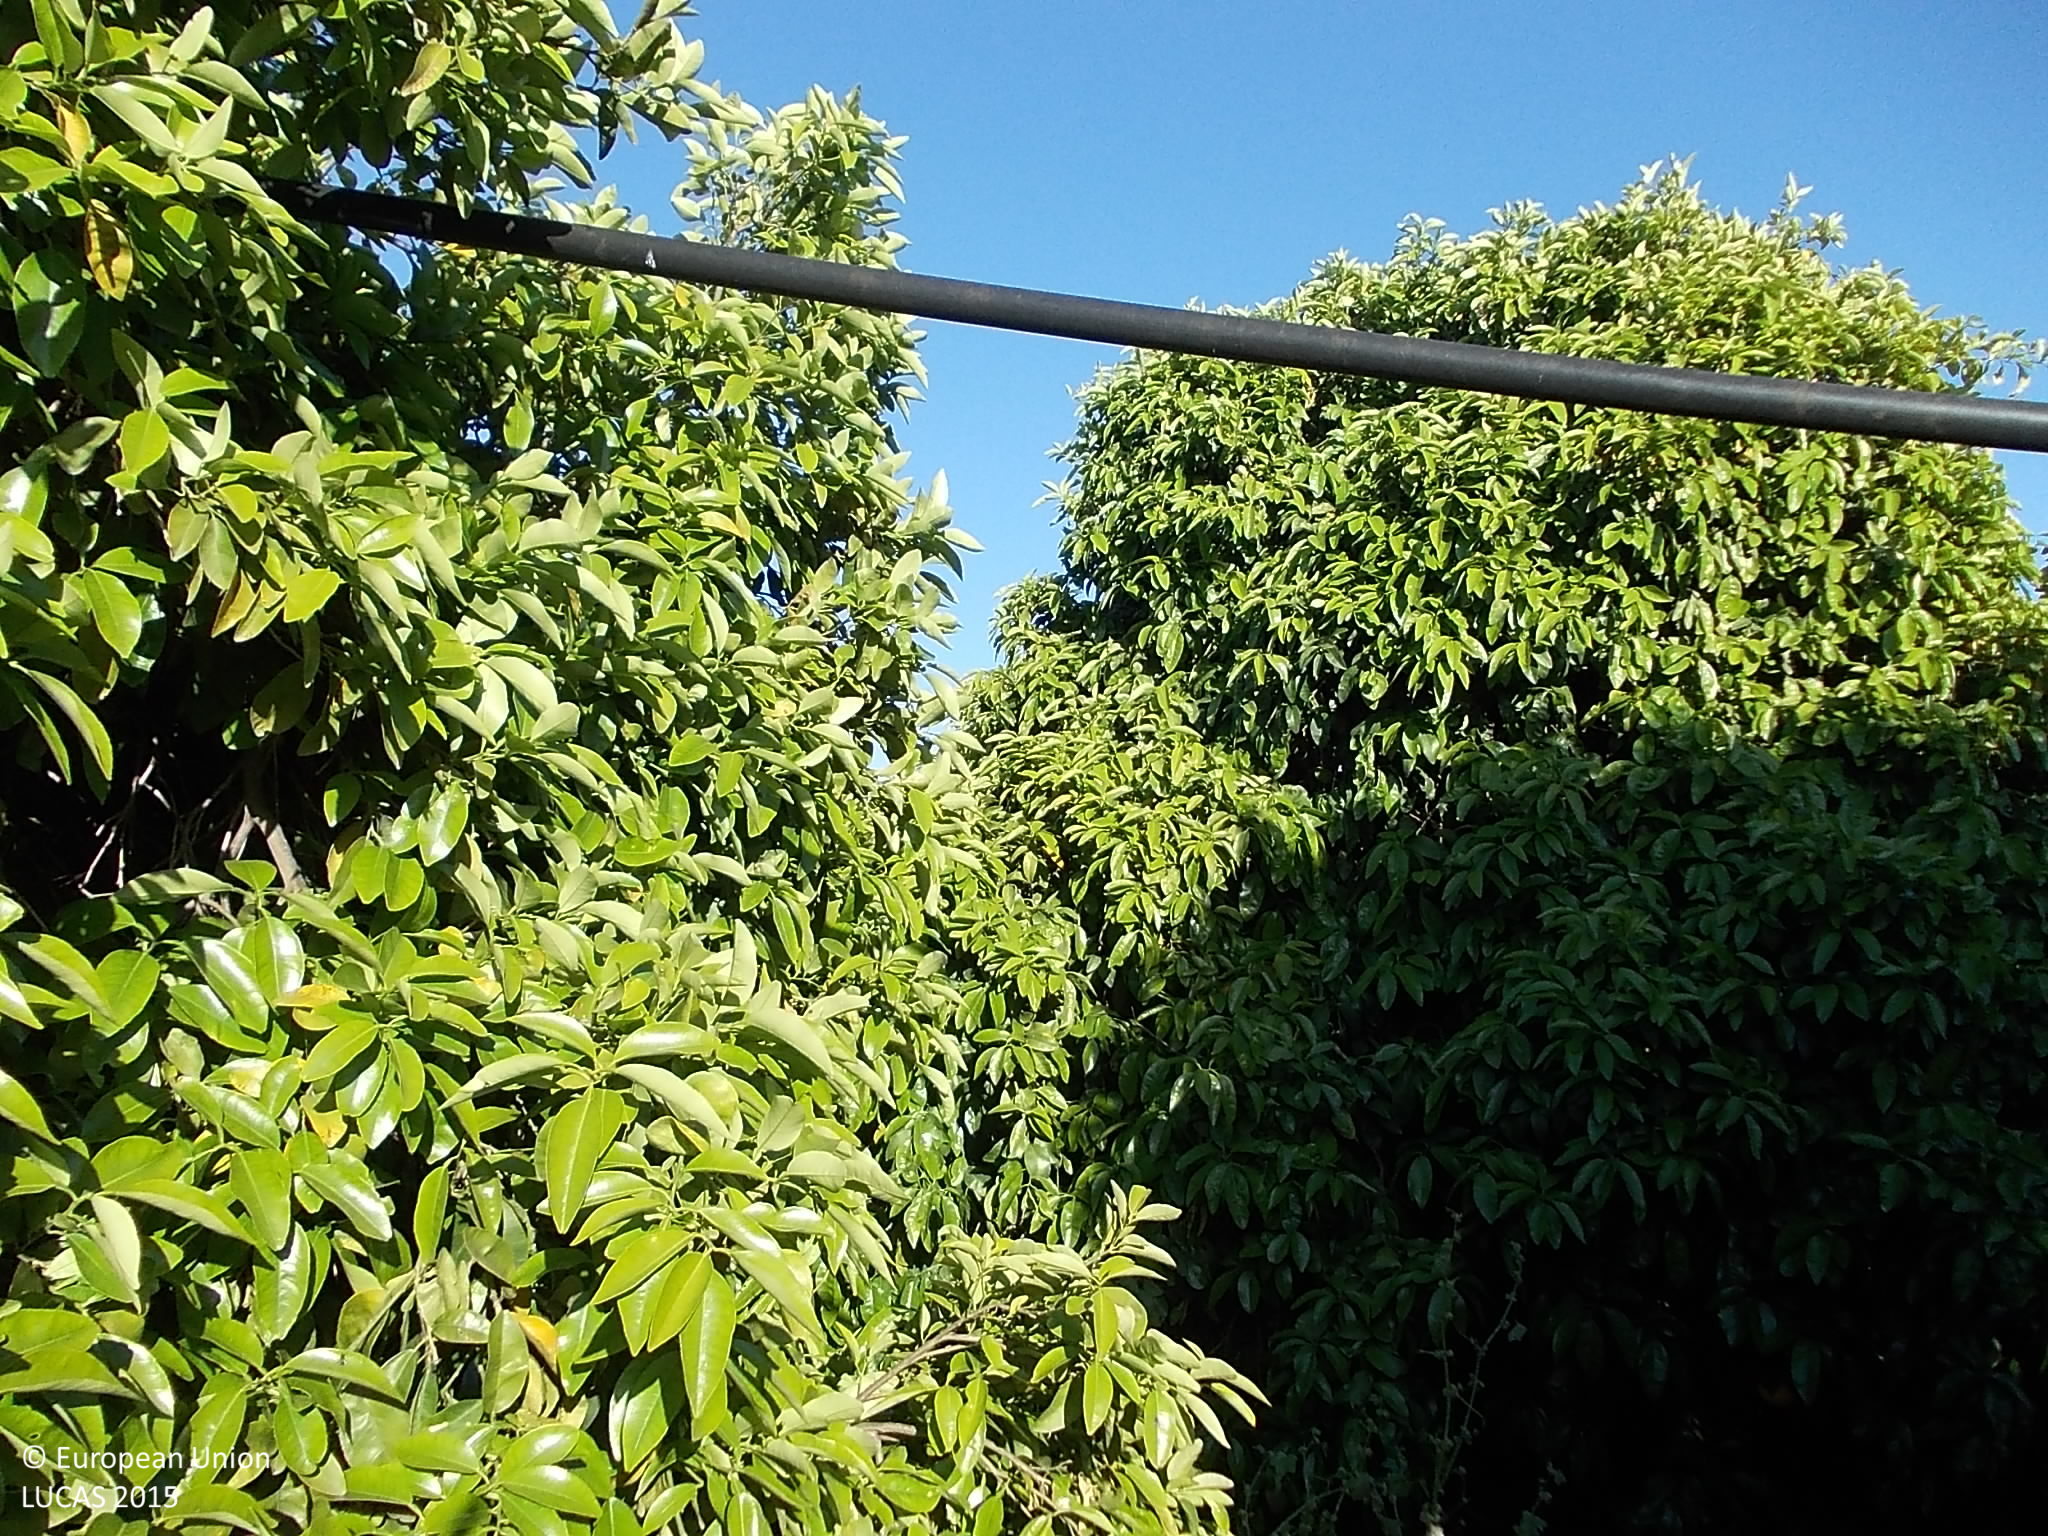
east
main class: Cropland
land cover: Oranges
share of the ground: > 75 %
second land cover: Spontaneously vegetated surfaces
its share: > 75 %
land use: Agriculture (excluding fallow land and kitchen gardens)
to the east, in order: Oranges; Spontaneously vegetated surfaces; Tracks; Spontaneously vegetated surfaces; Other bare soil; Single bushes/trees; Spontaneously vegetated surfaces
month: April
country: CY
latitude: 34.6850
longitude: 32.9862
